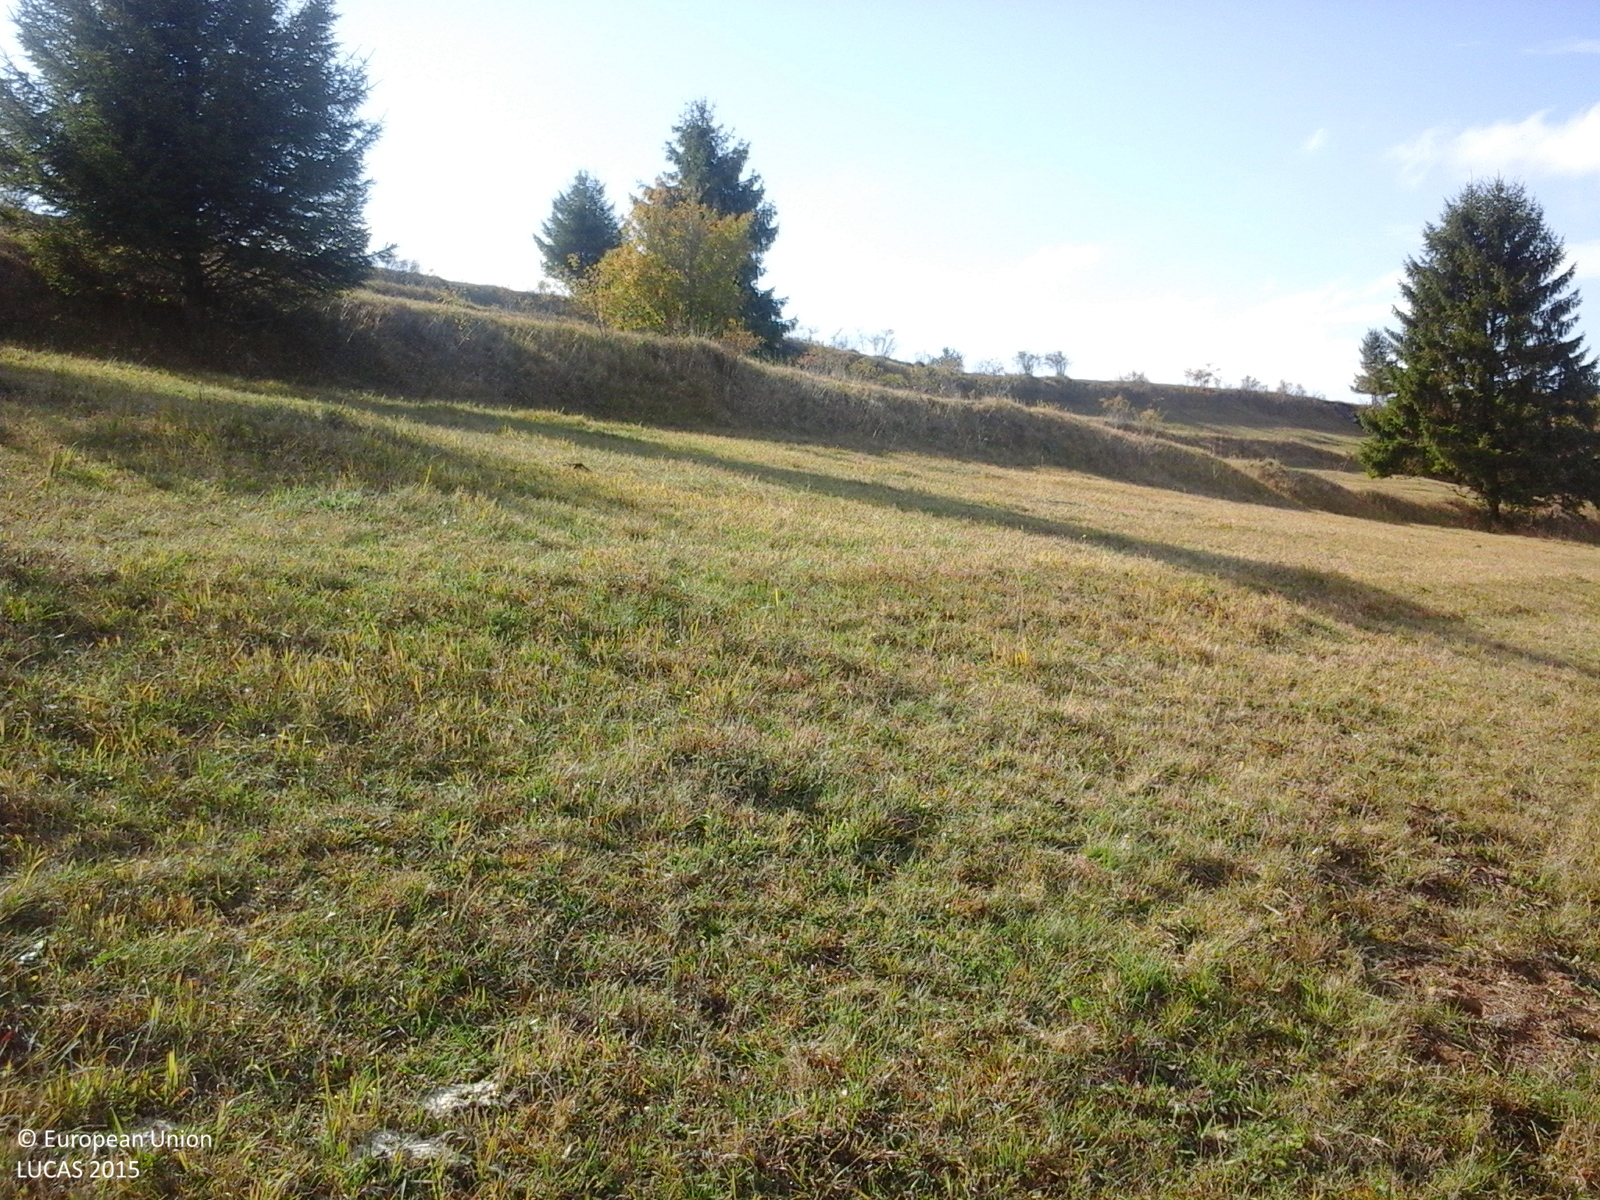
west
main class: Grassland
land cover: Grassland without tree/shrub cover
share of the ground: > 75 %
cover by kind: herbaceous plants 100 %
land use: Agriculture (excluding fallow land and kitchen gardens)
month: October
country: RO
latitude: 46.3225
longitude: 25.9243
